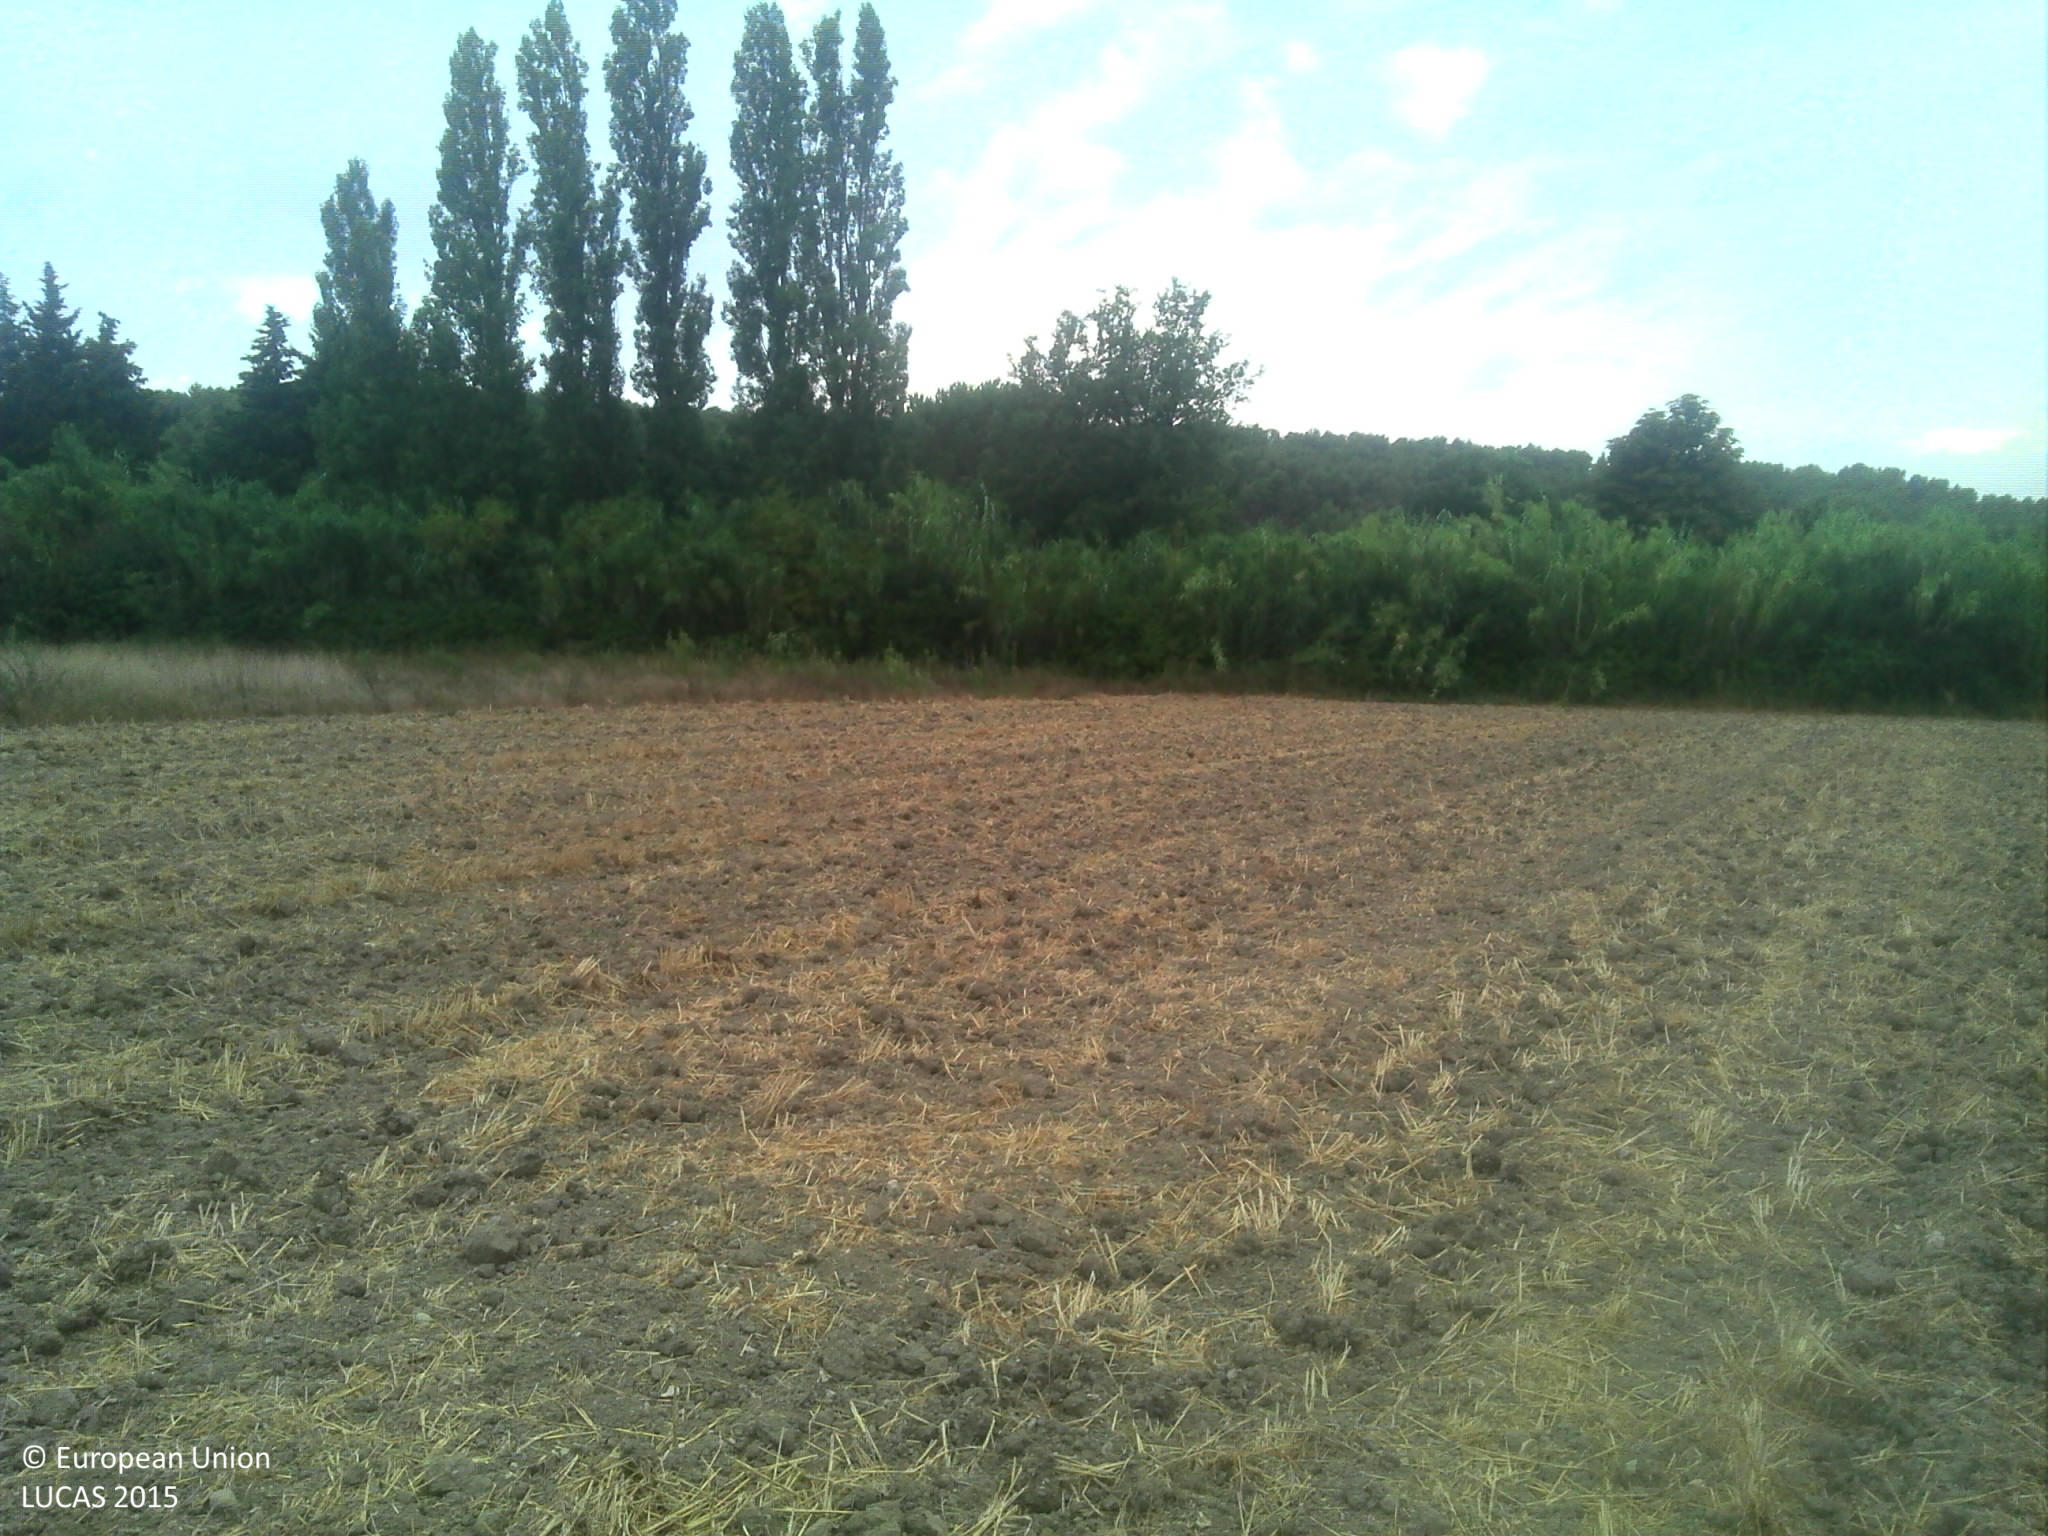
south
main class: Cropland
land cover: Durum wheat
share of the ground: 10 - 25 %
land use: Agriculture (excluding fallow land and kitchen gardens)
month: August
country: FR
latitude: 43.4525
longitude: 5.3758
